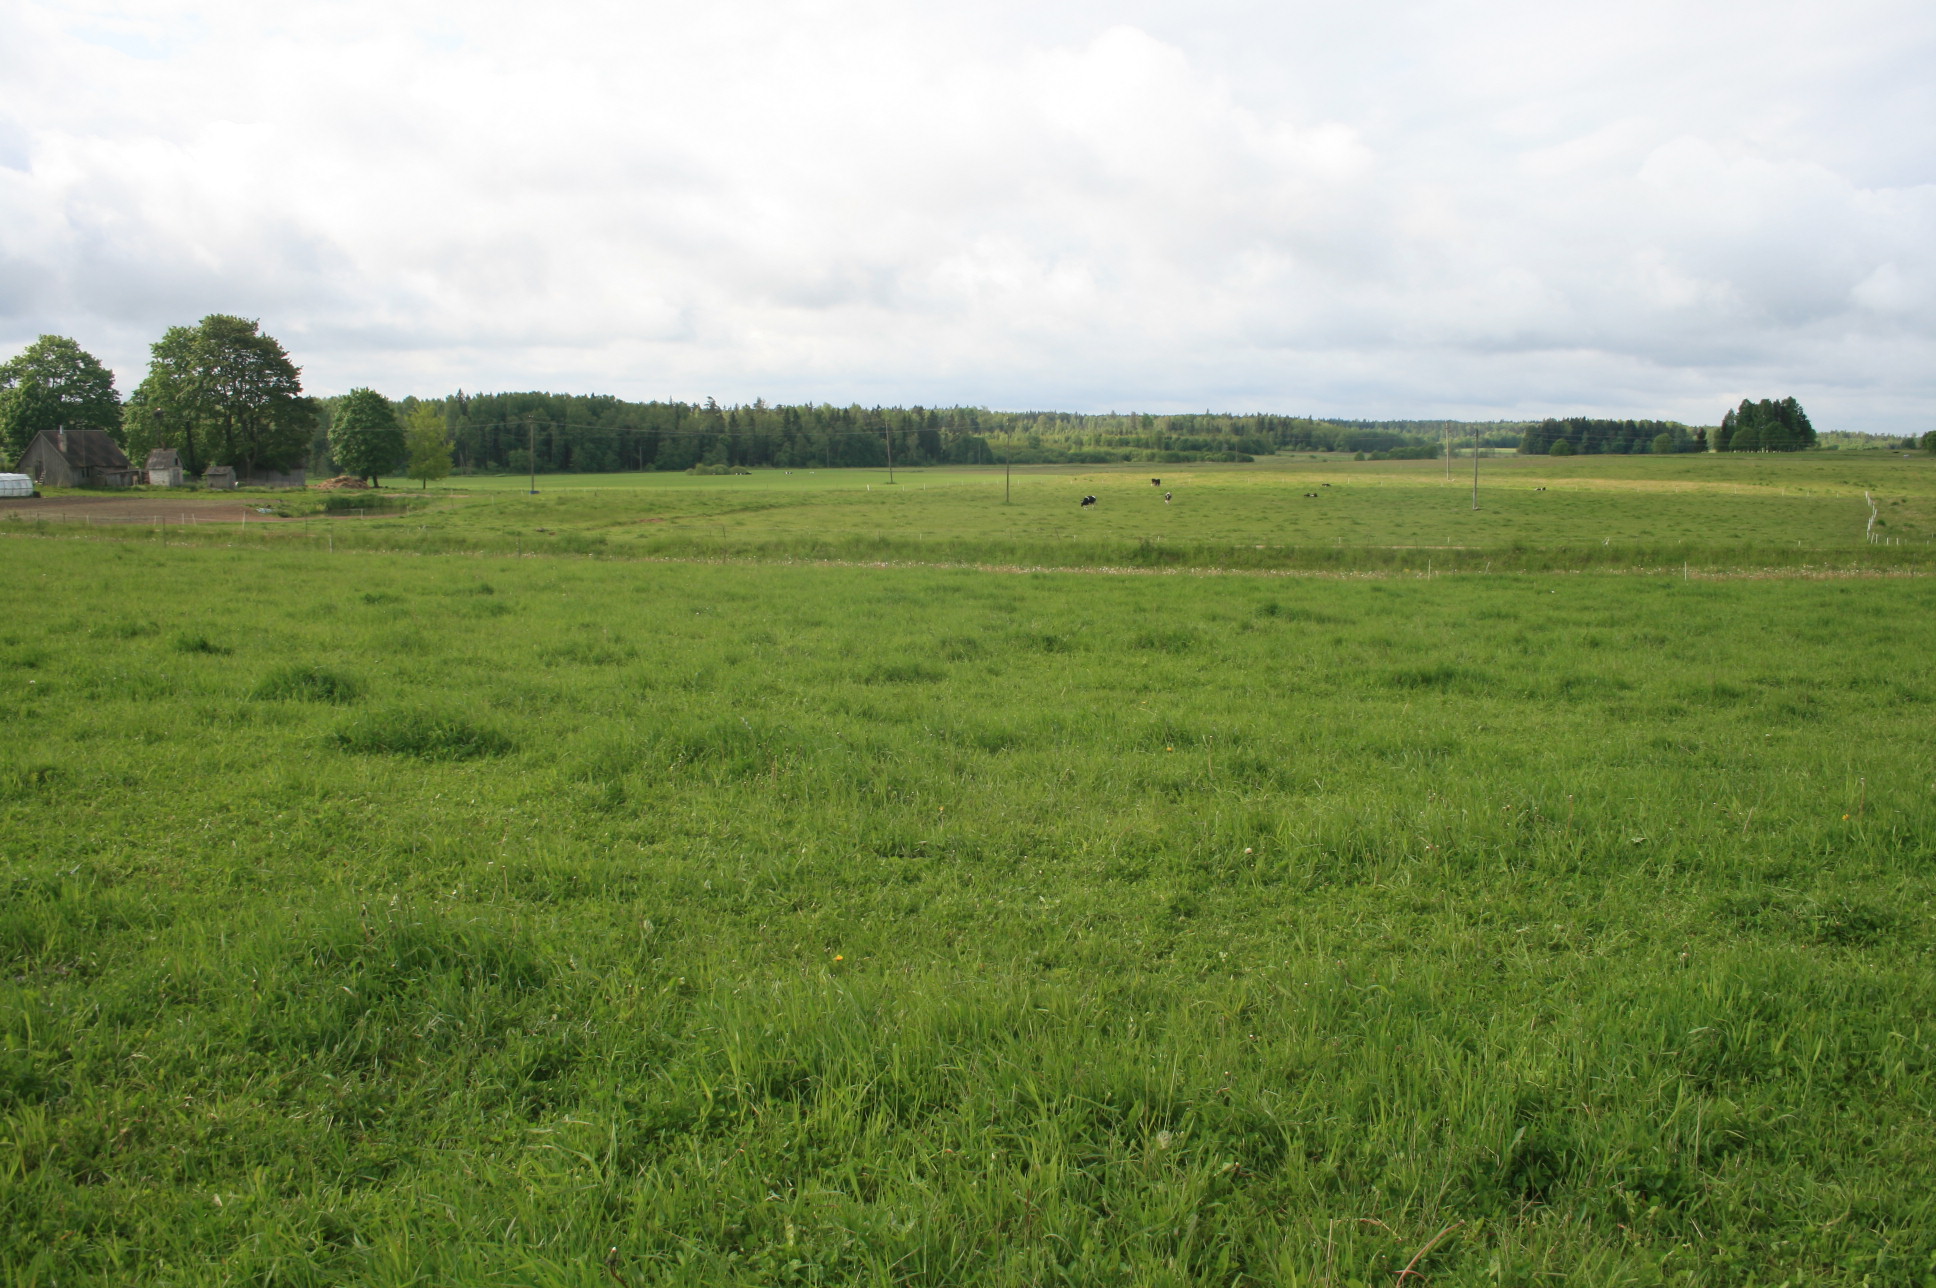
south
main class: Grassland
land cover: Grassland without tree/shrub cover
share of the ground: > 75 %
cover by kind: herbaceous plants 100 %
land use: Agriculture (excluding fallow land and kitchen gardens)
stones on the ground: < 10 %
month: May
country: LT
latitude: 55.7982
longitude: 21.8703
